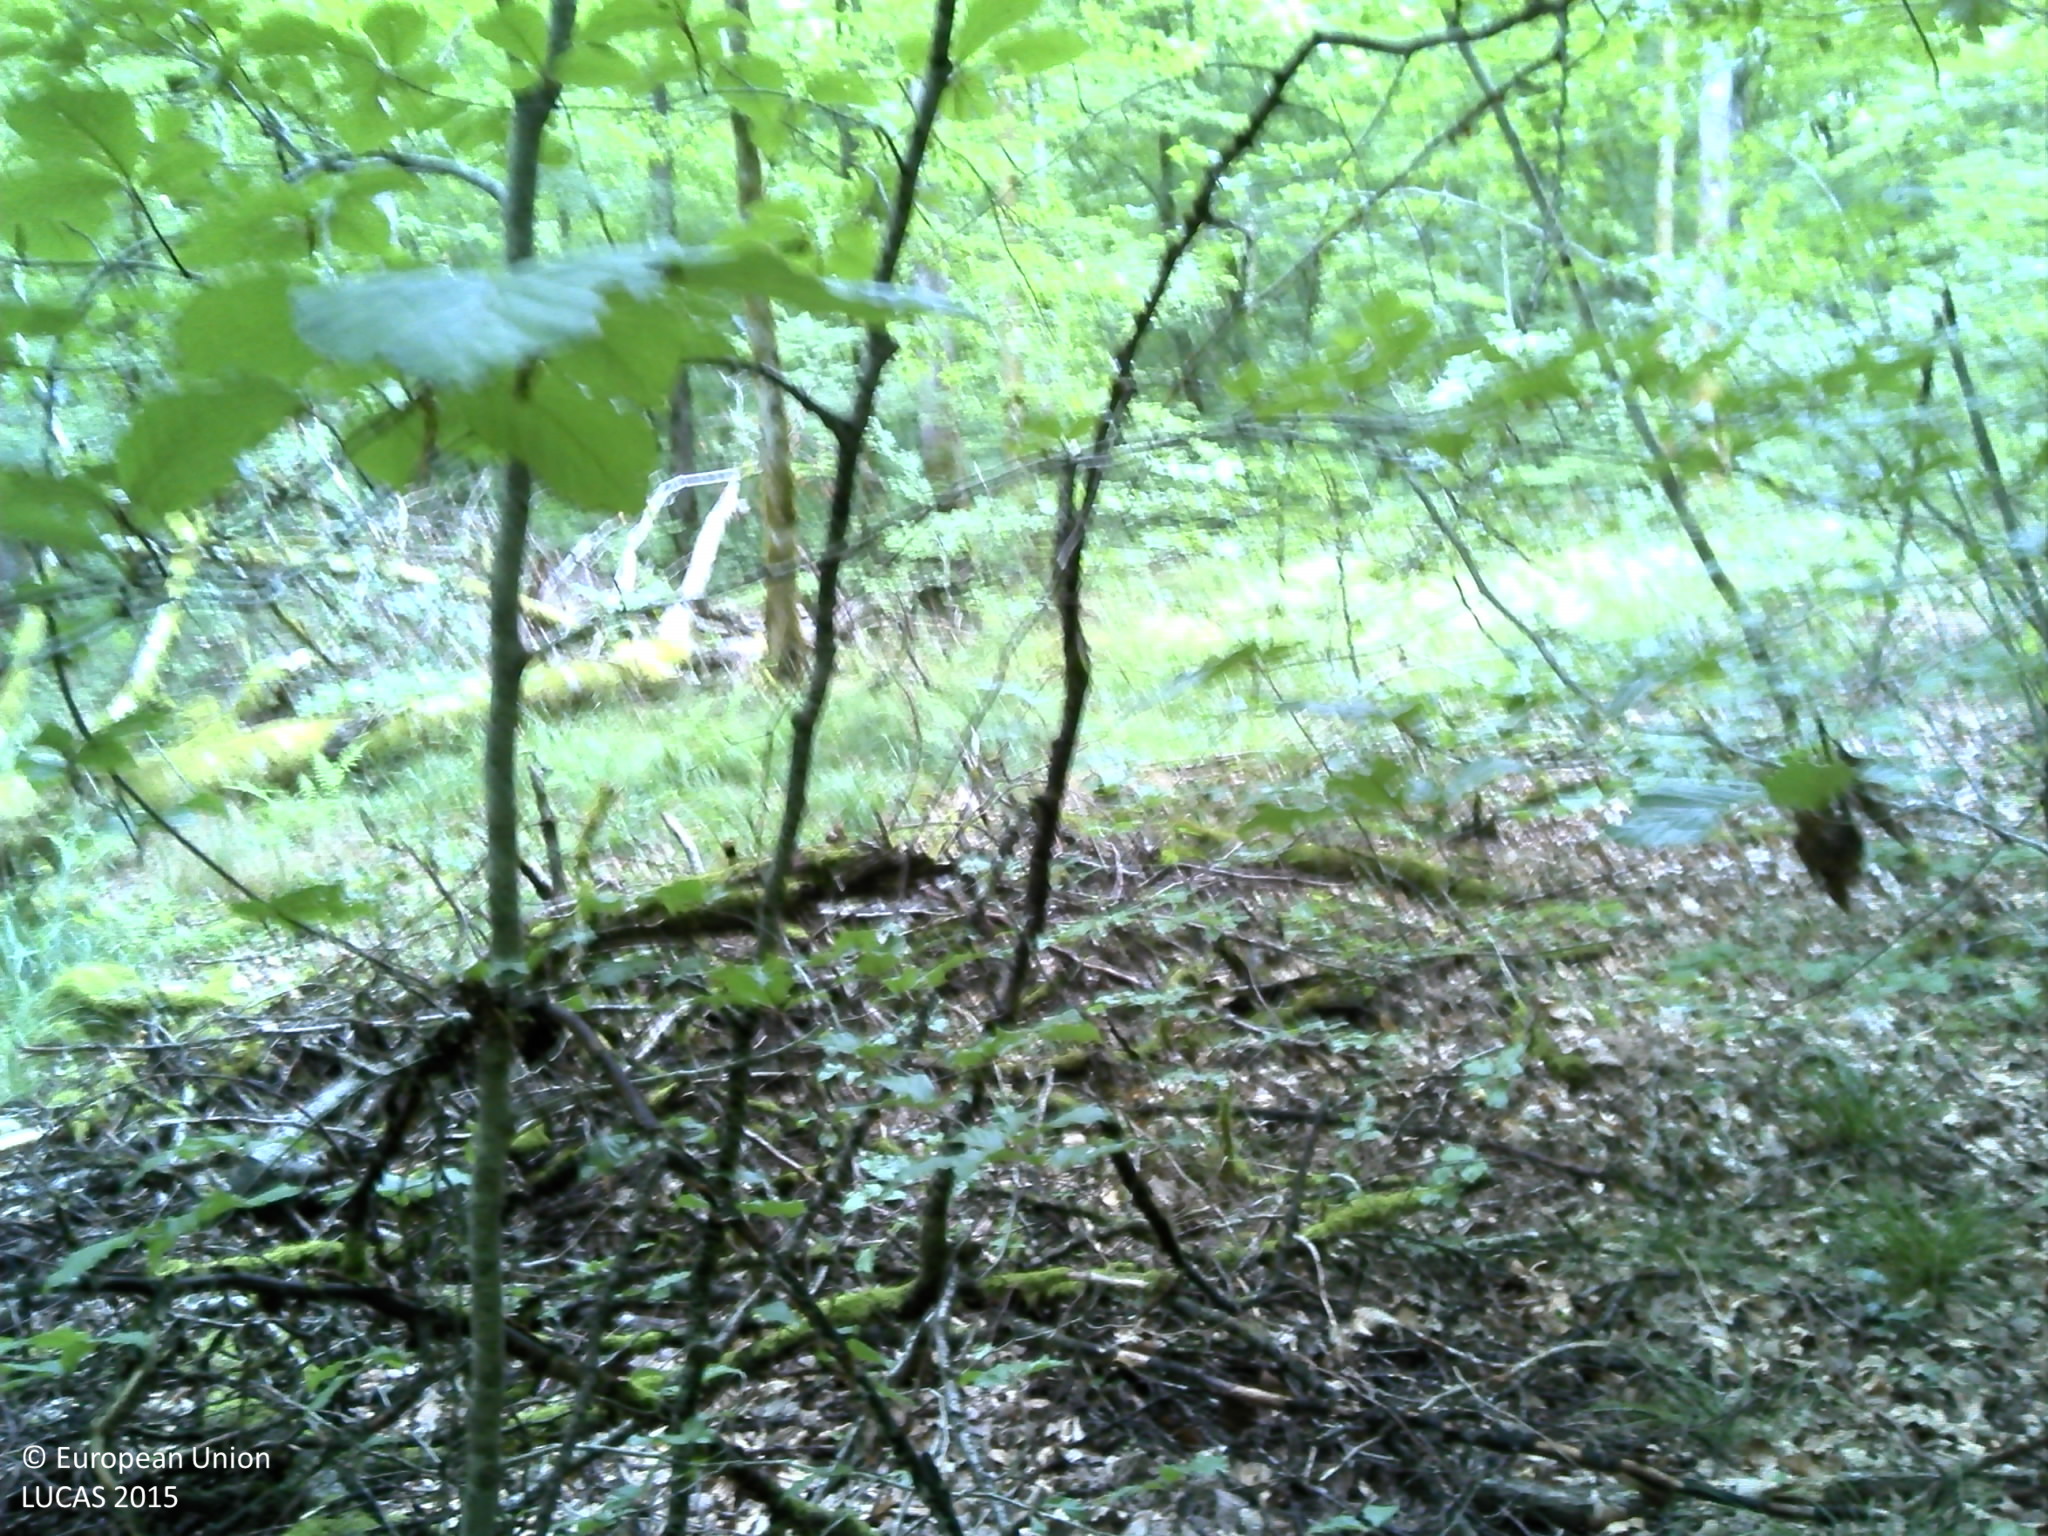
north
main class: Woodland
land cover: Broadleaved woodland
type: beech forest
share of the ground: > 75 %
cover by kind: broadleaved forest trees 100 %
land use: Forestry
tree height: > 5 m
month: July
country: FR
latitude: 48.1003
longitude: 6.0928
